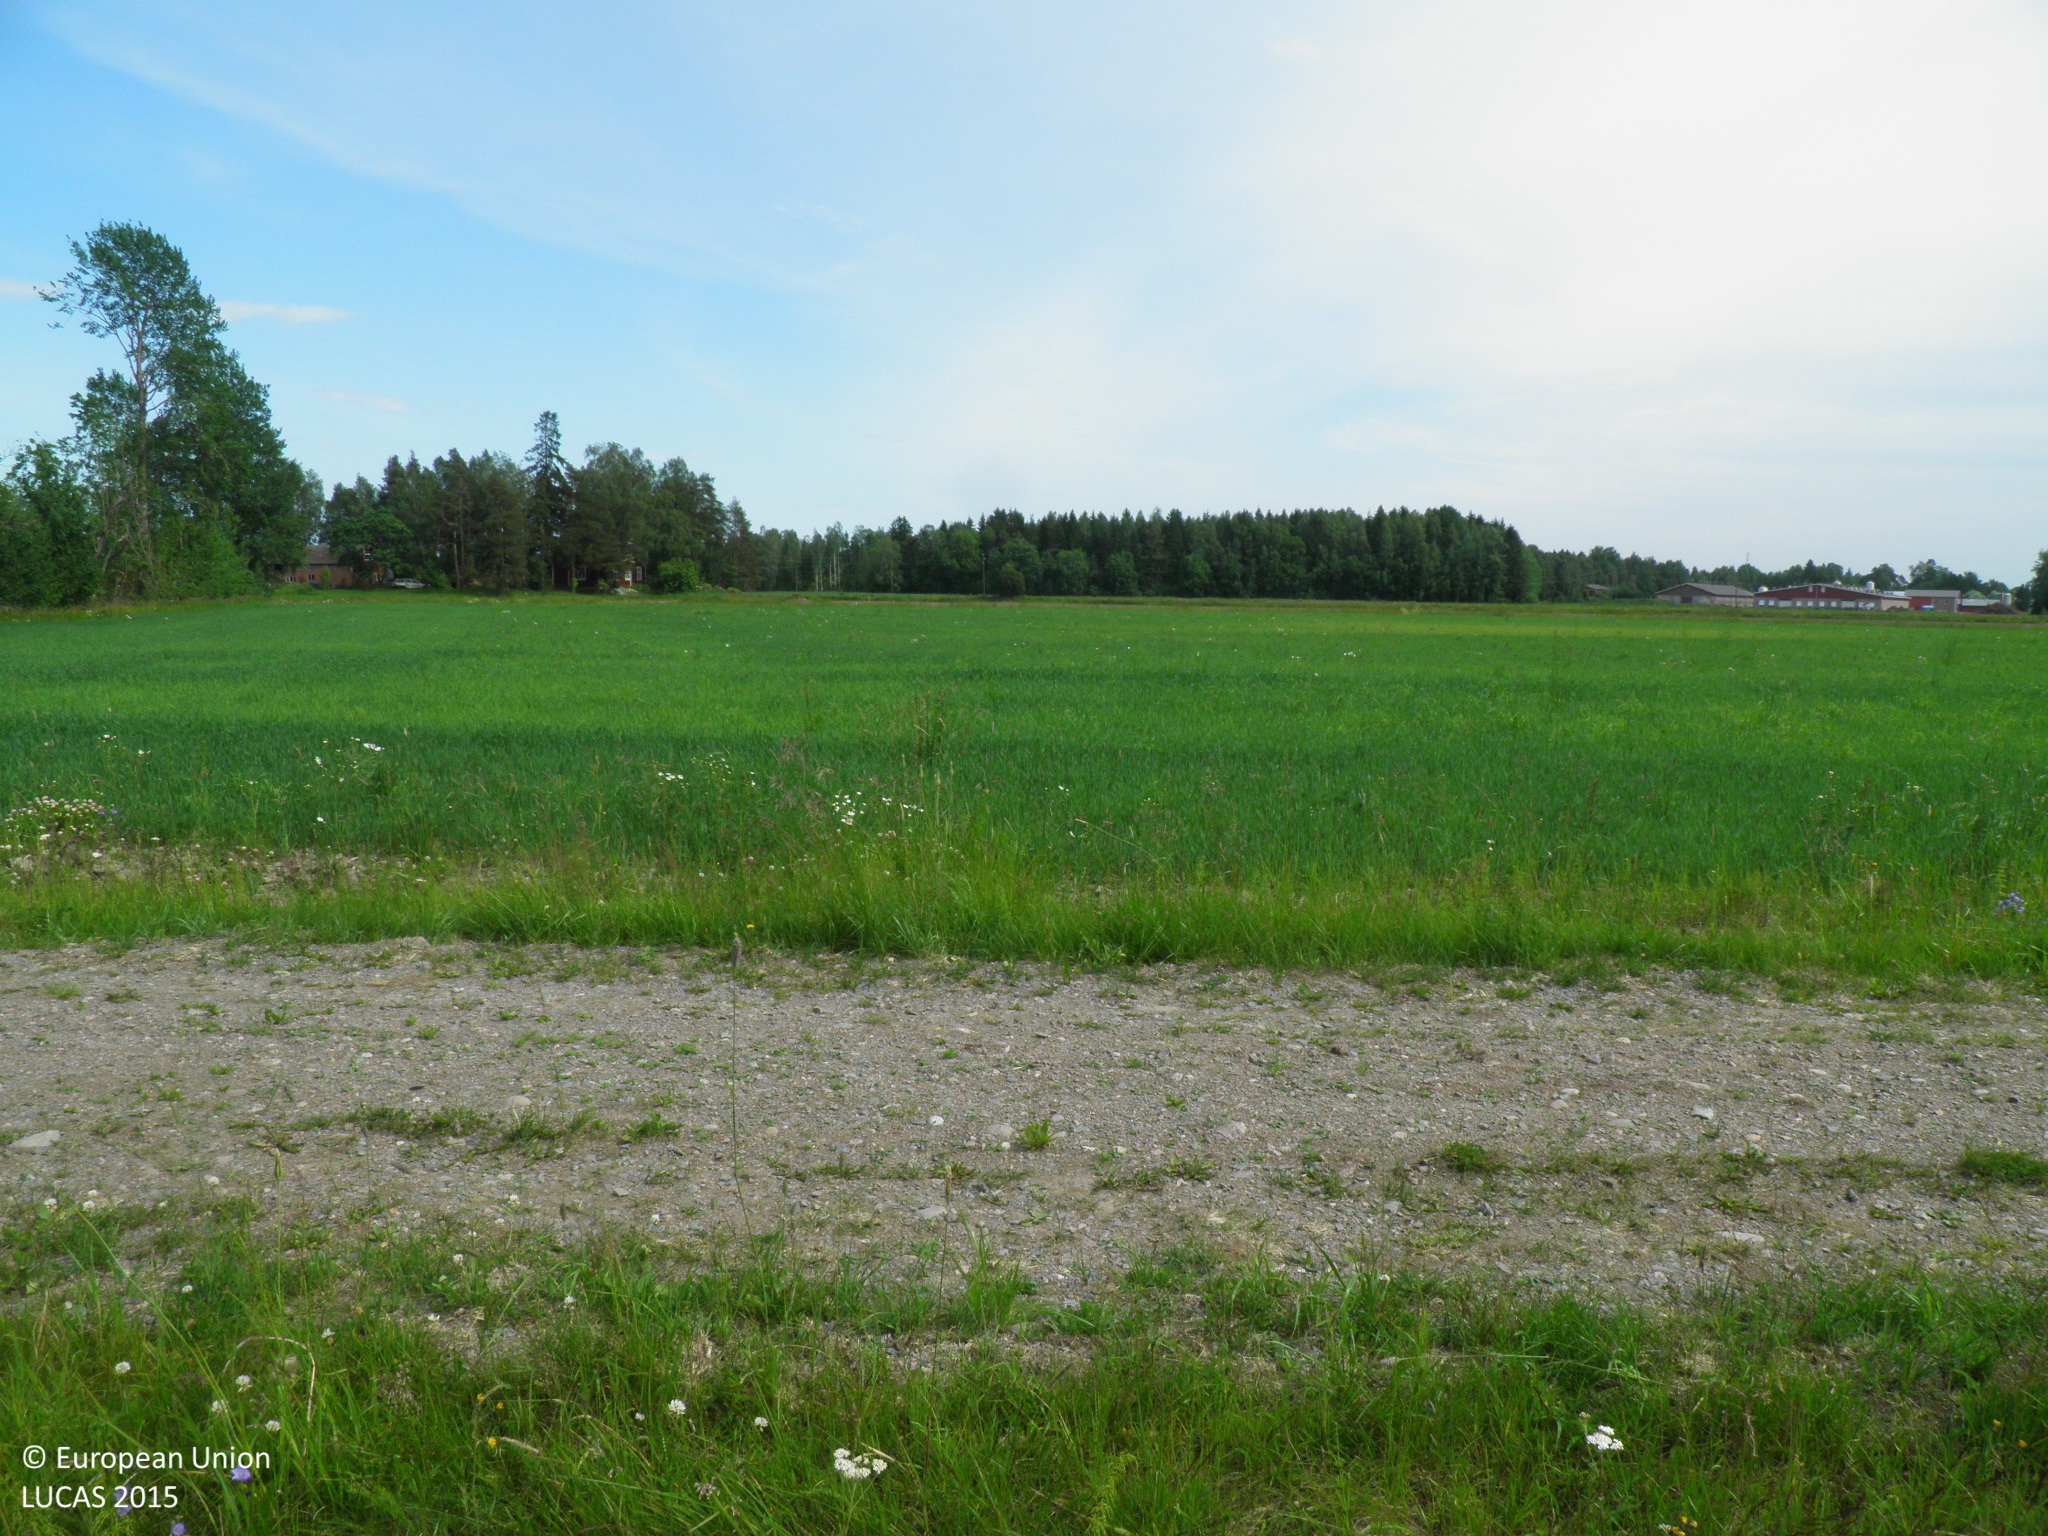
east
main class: Cropland
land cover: Common wheat
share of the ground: > 75 %
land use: Agriculture (excluding fallow land and kitchen gardens)
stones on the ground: < 10 %
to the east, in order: Common wheat; Ditches and canals; Tracks; Ditches and canals; Common wheat; Grass margins; Ditches and canals; Grass margins; Other bare soil
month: July
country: FI
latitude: 60.7151
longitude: 22.7364
